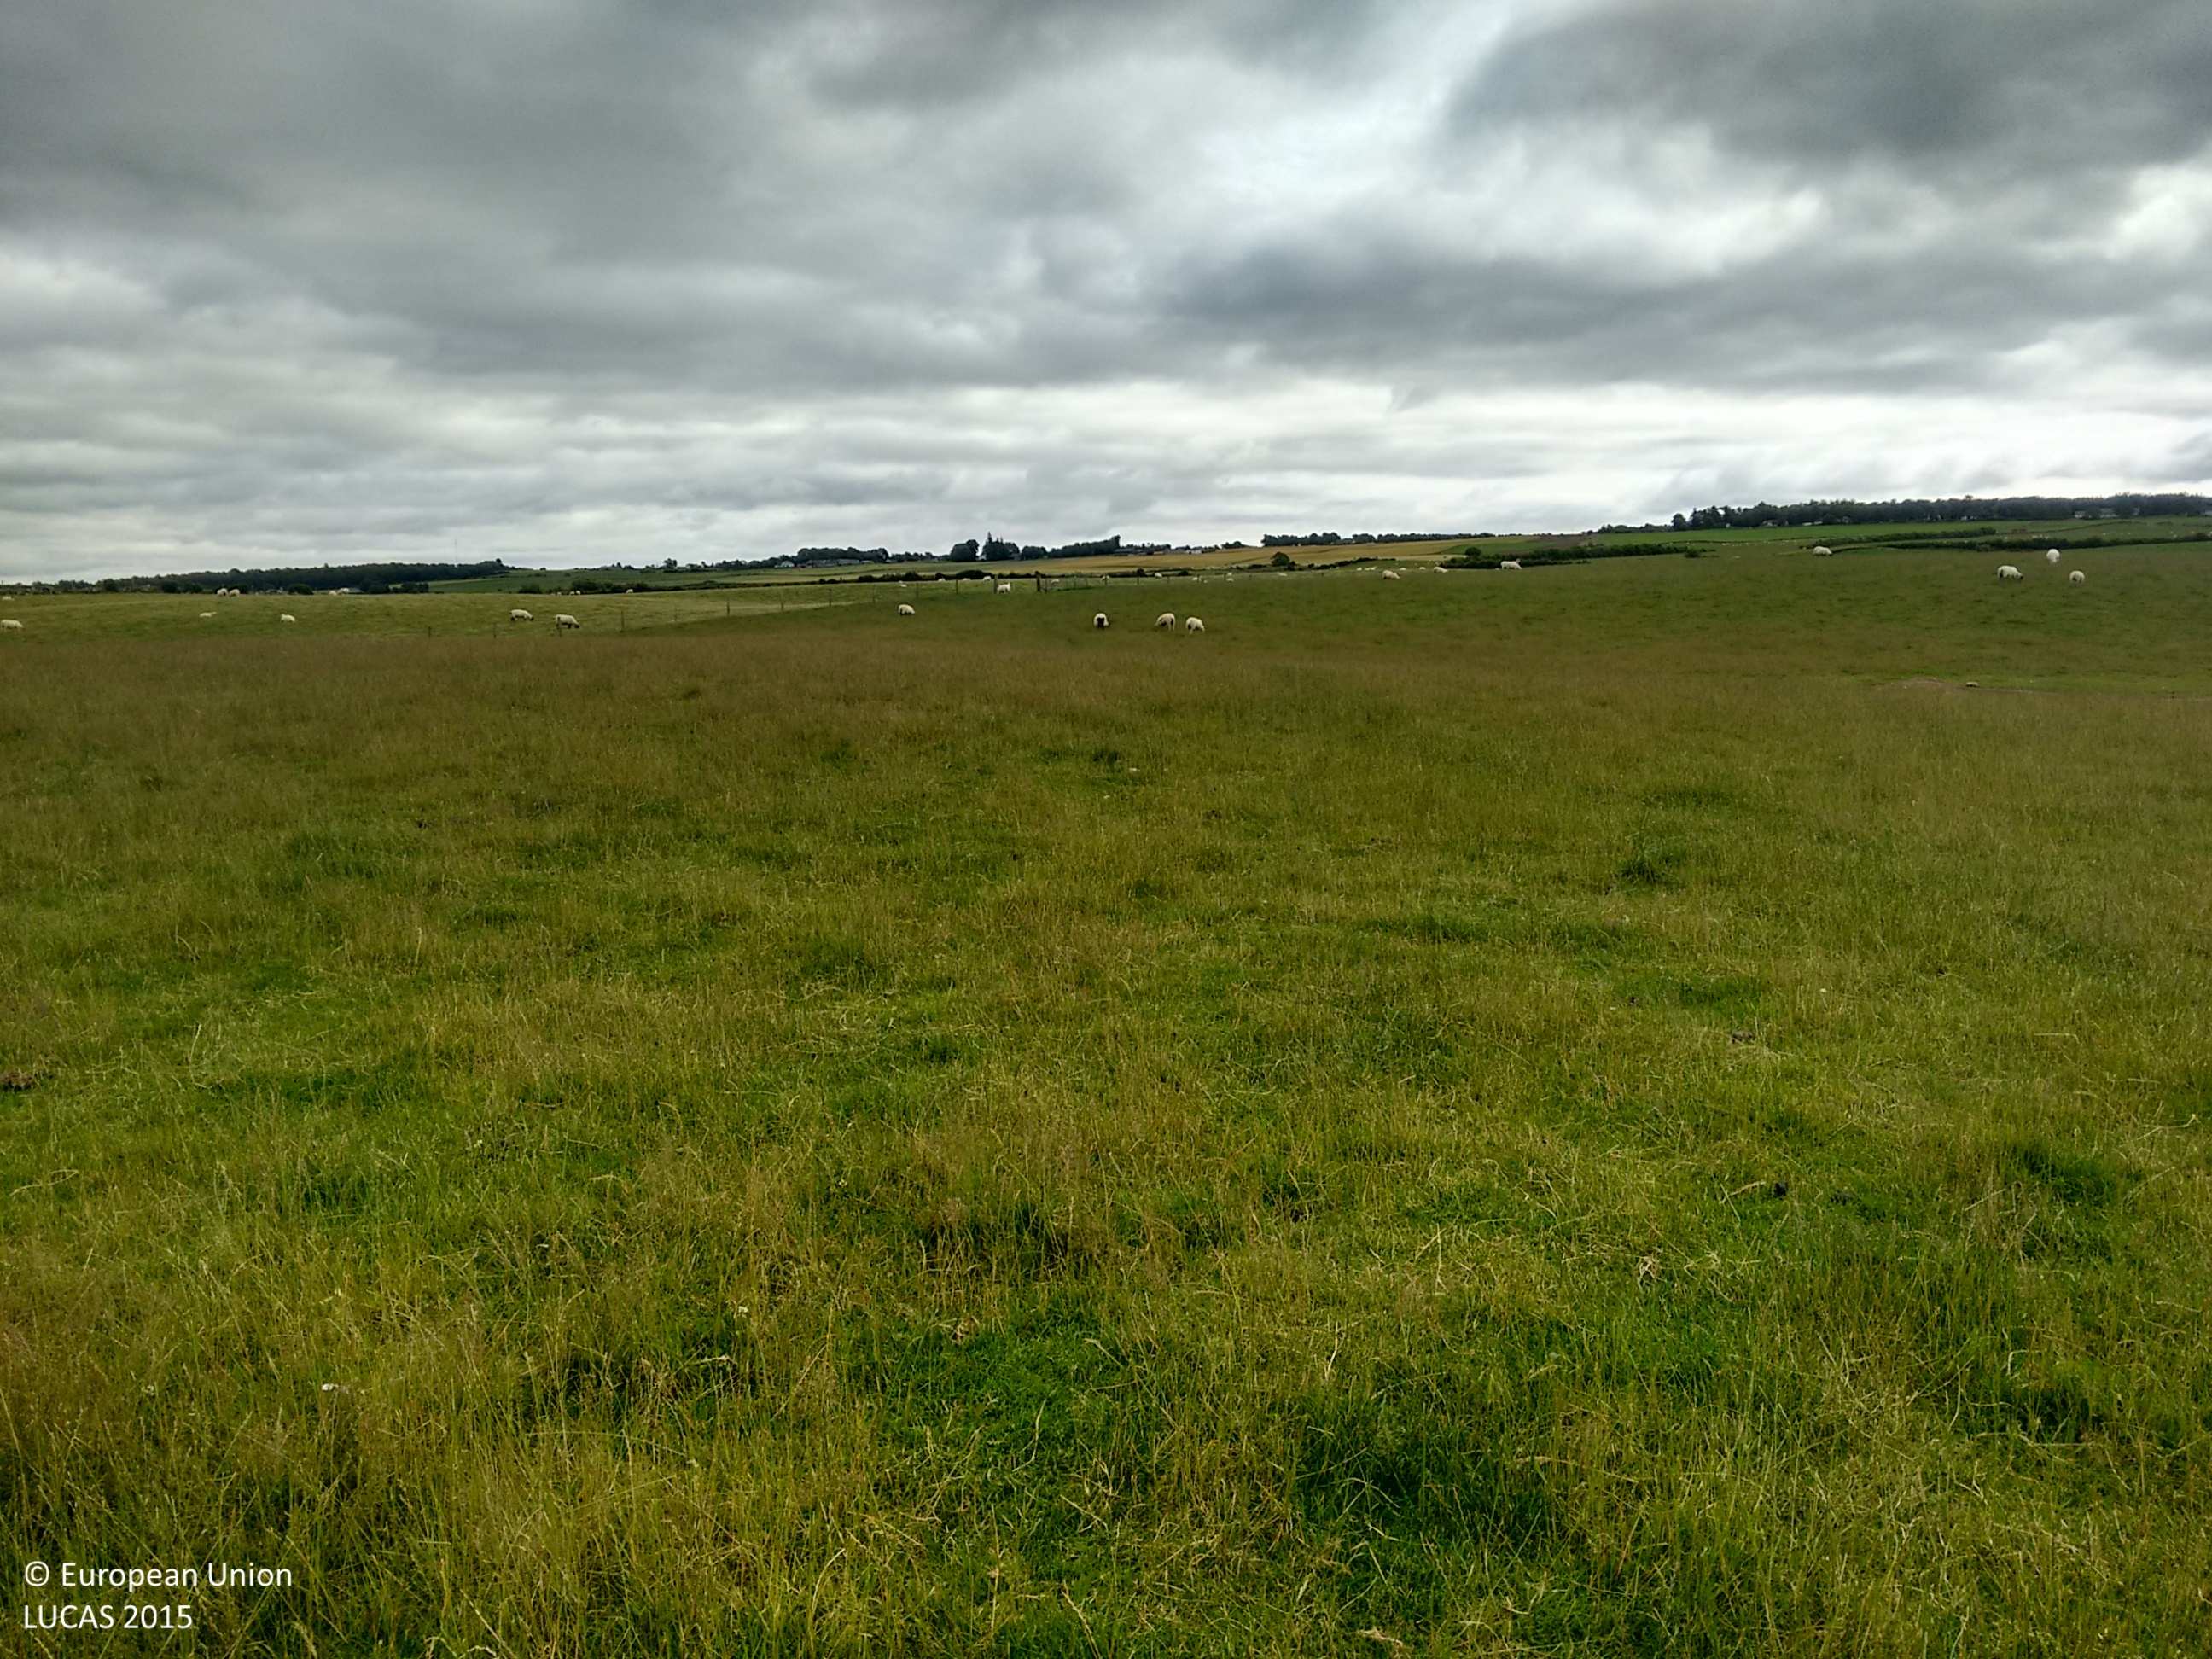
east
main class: Grassland
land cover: Grassland without tree/shrub cover
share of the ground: > 75 %
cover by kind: herbaceous plants 100 %
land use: Agriculture (excluding fallow land and kitchen gardens)
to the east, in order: Grassland without tree/shrub cover; Fences; Grassland without tree/shrub cover
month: August
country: GB
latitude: 57.5647
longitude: -4.4151
